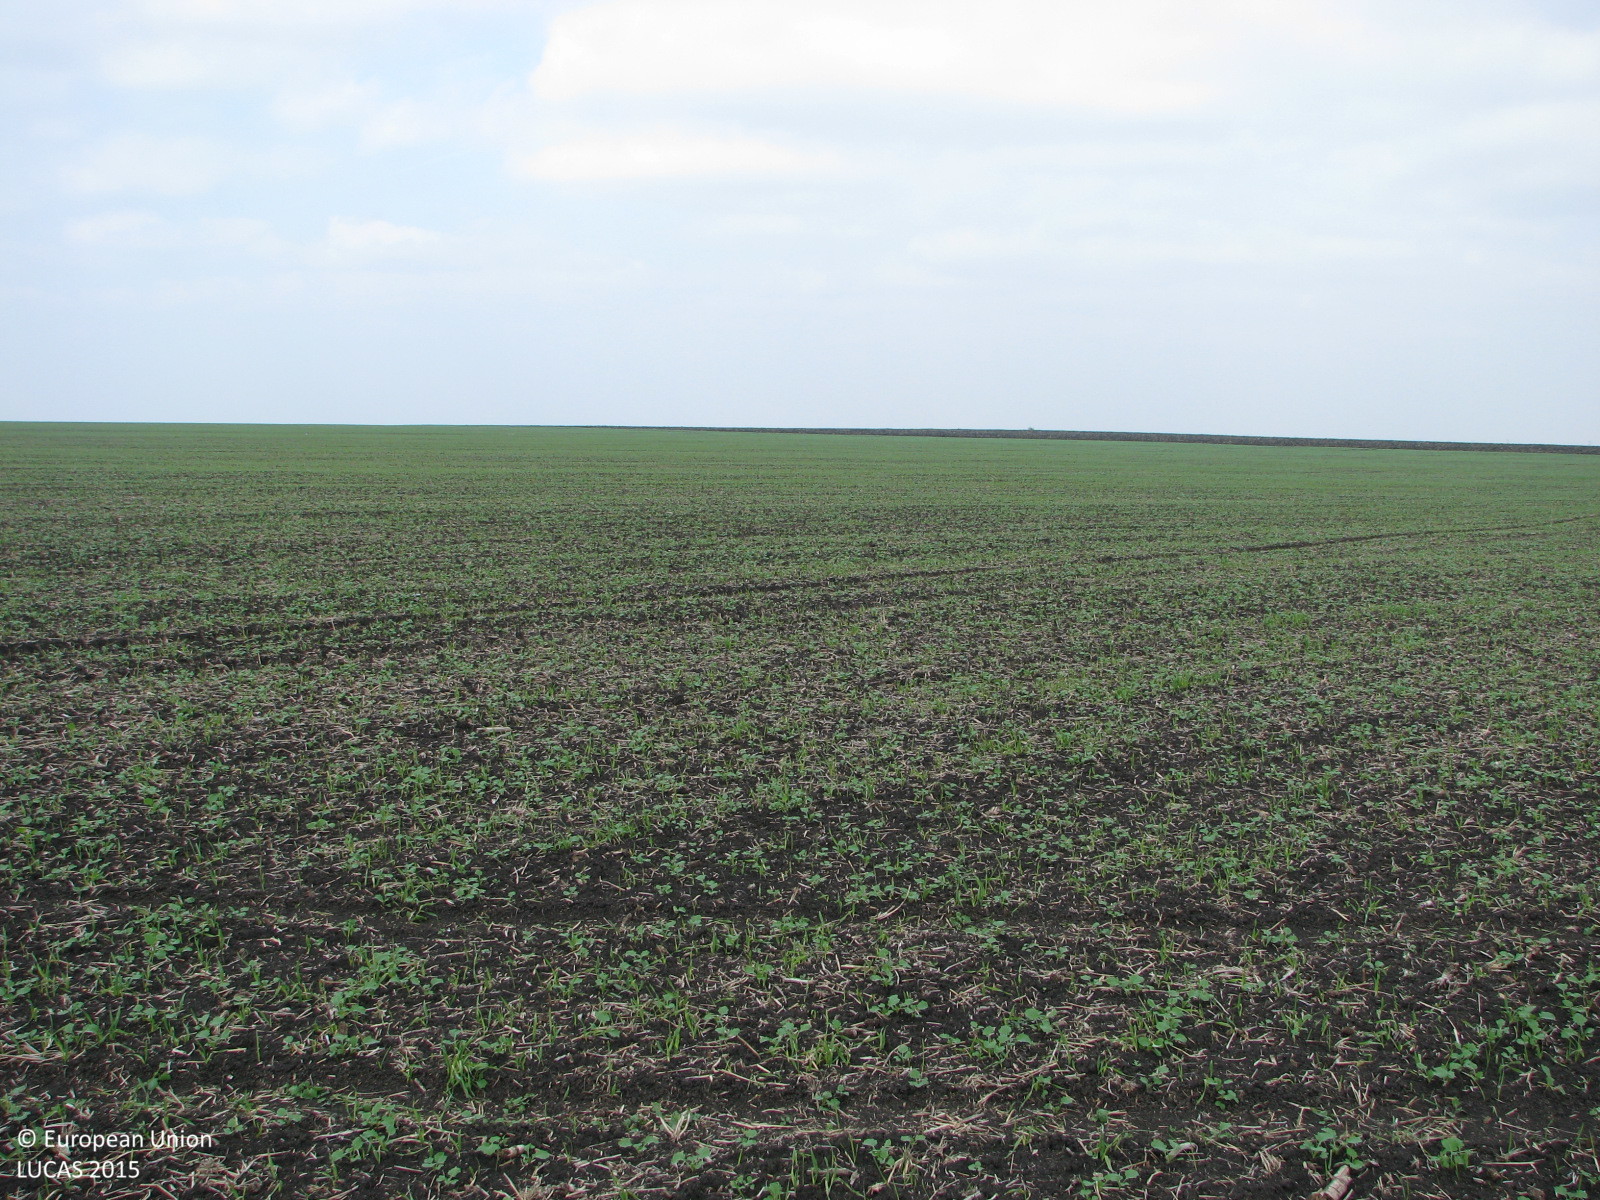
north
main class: Cropland
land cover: Rape and turnip rape
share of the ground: 10 - 25 %
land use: Agriculture (excluding fallow land and kitchen gardens)
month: October
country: BG
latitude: 42.3012
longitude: 26.5019
